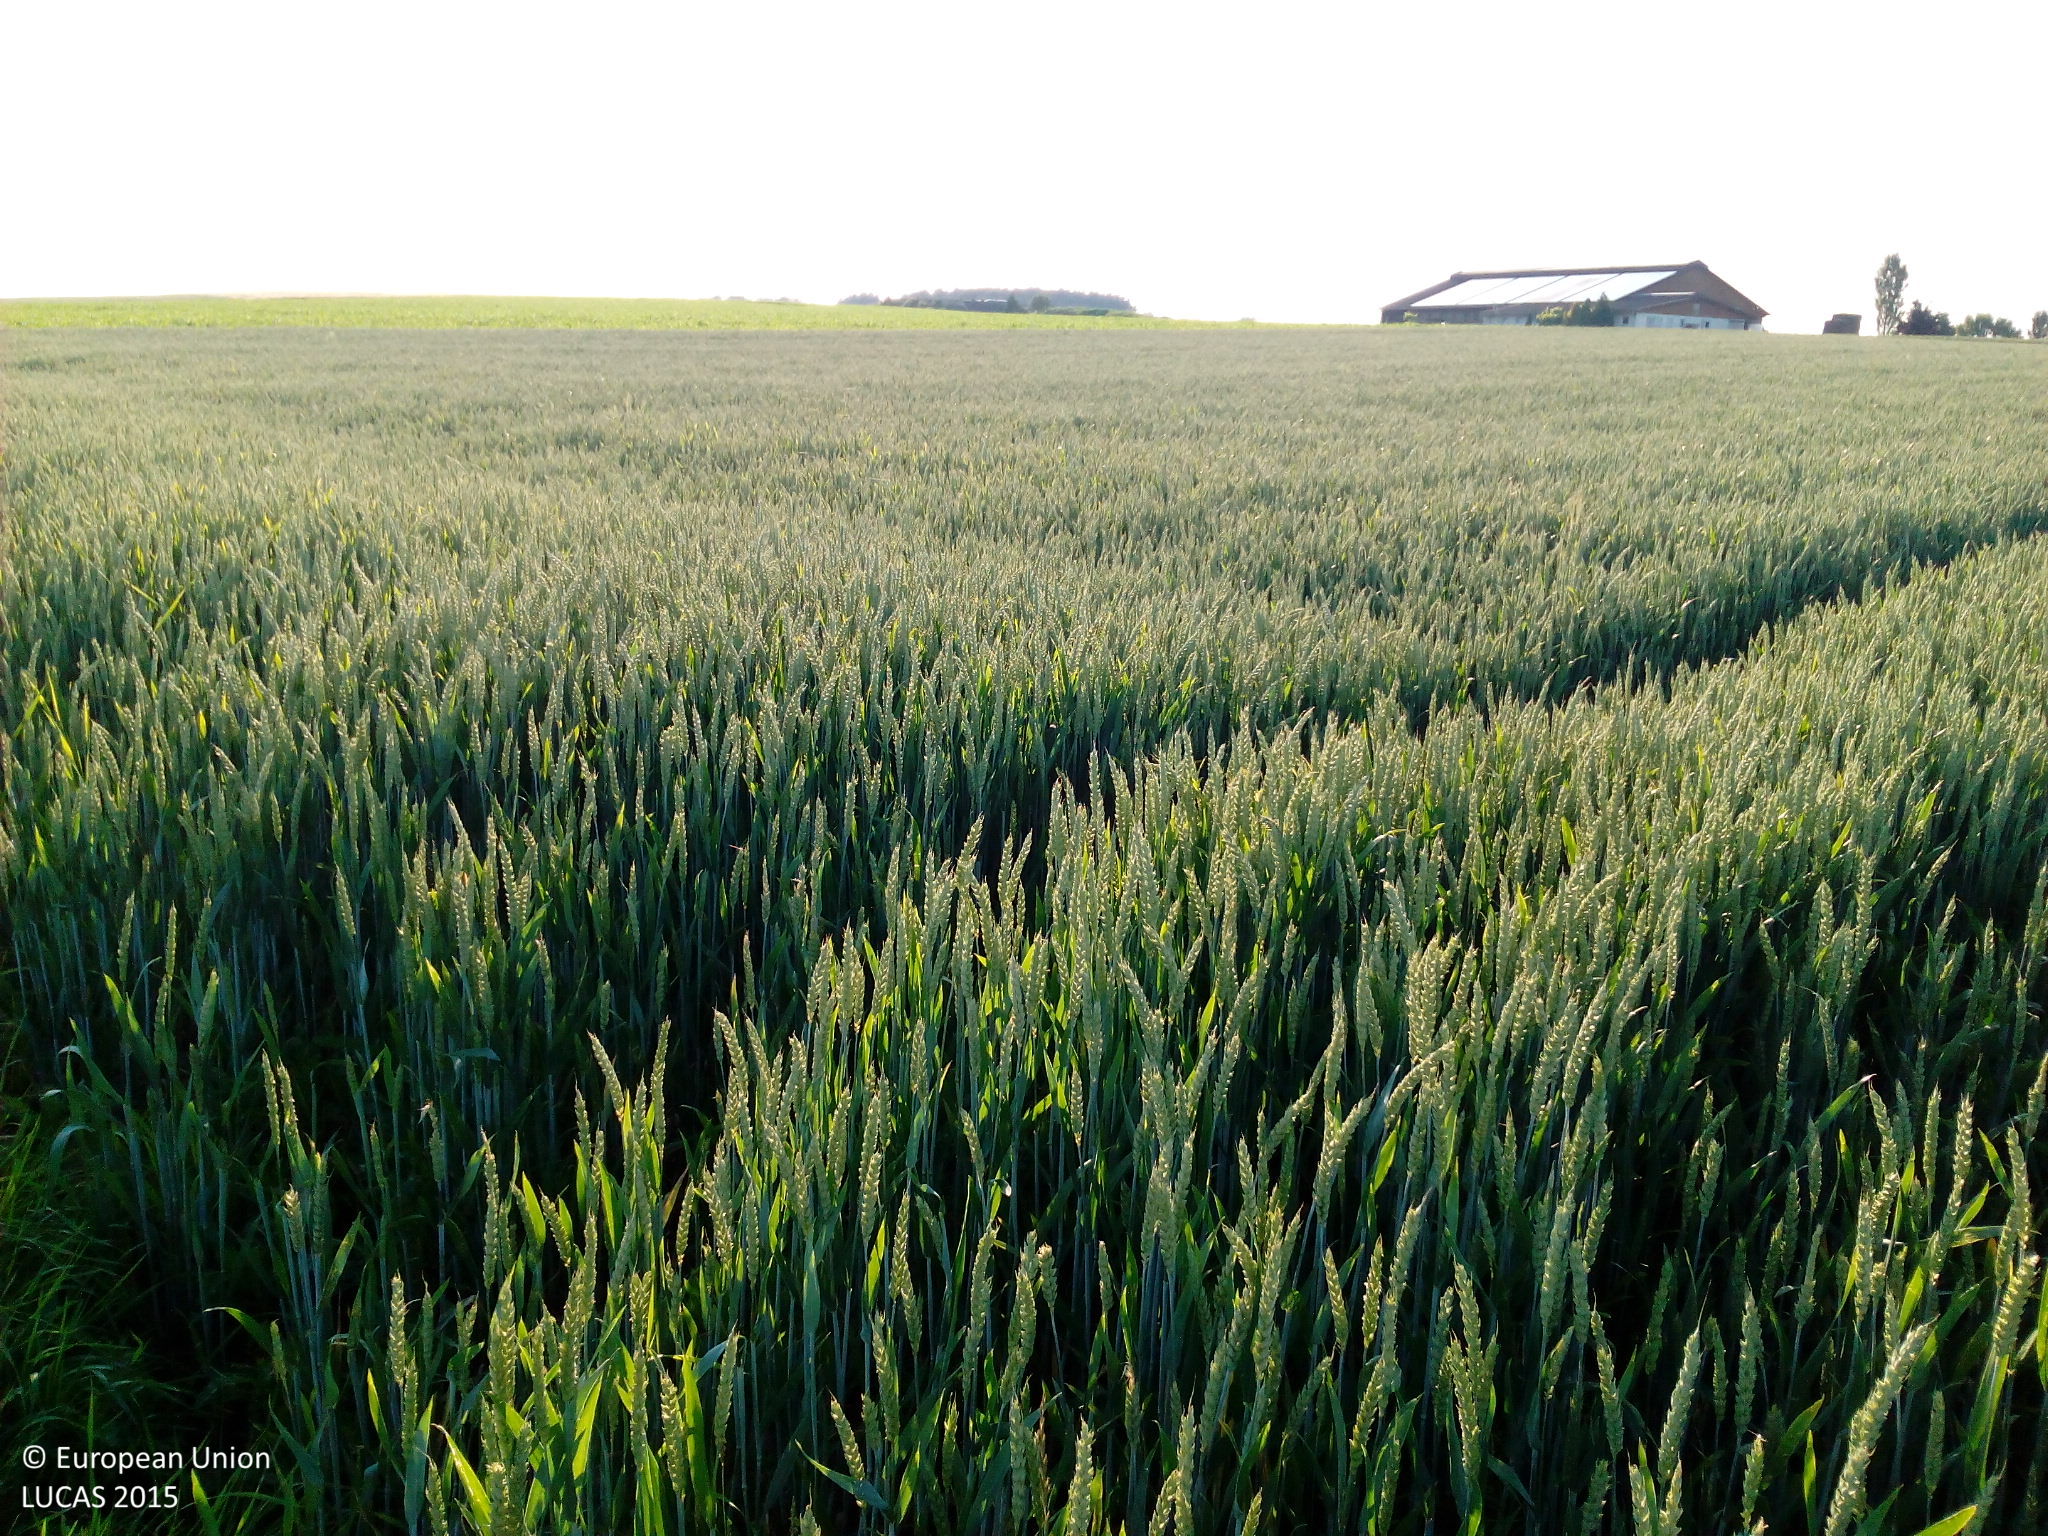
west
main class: Cropland
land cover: Common wheat
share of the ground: > 75 %
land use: Agriculture (excluding fallow land and kitchen gardens)
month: June
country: DE
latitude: 48.3134
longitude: 9.8518
